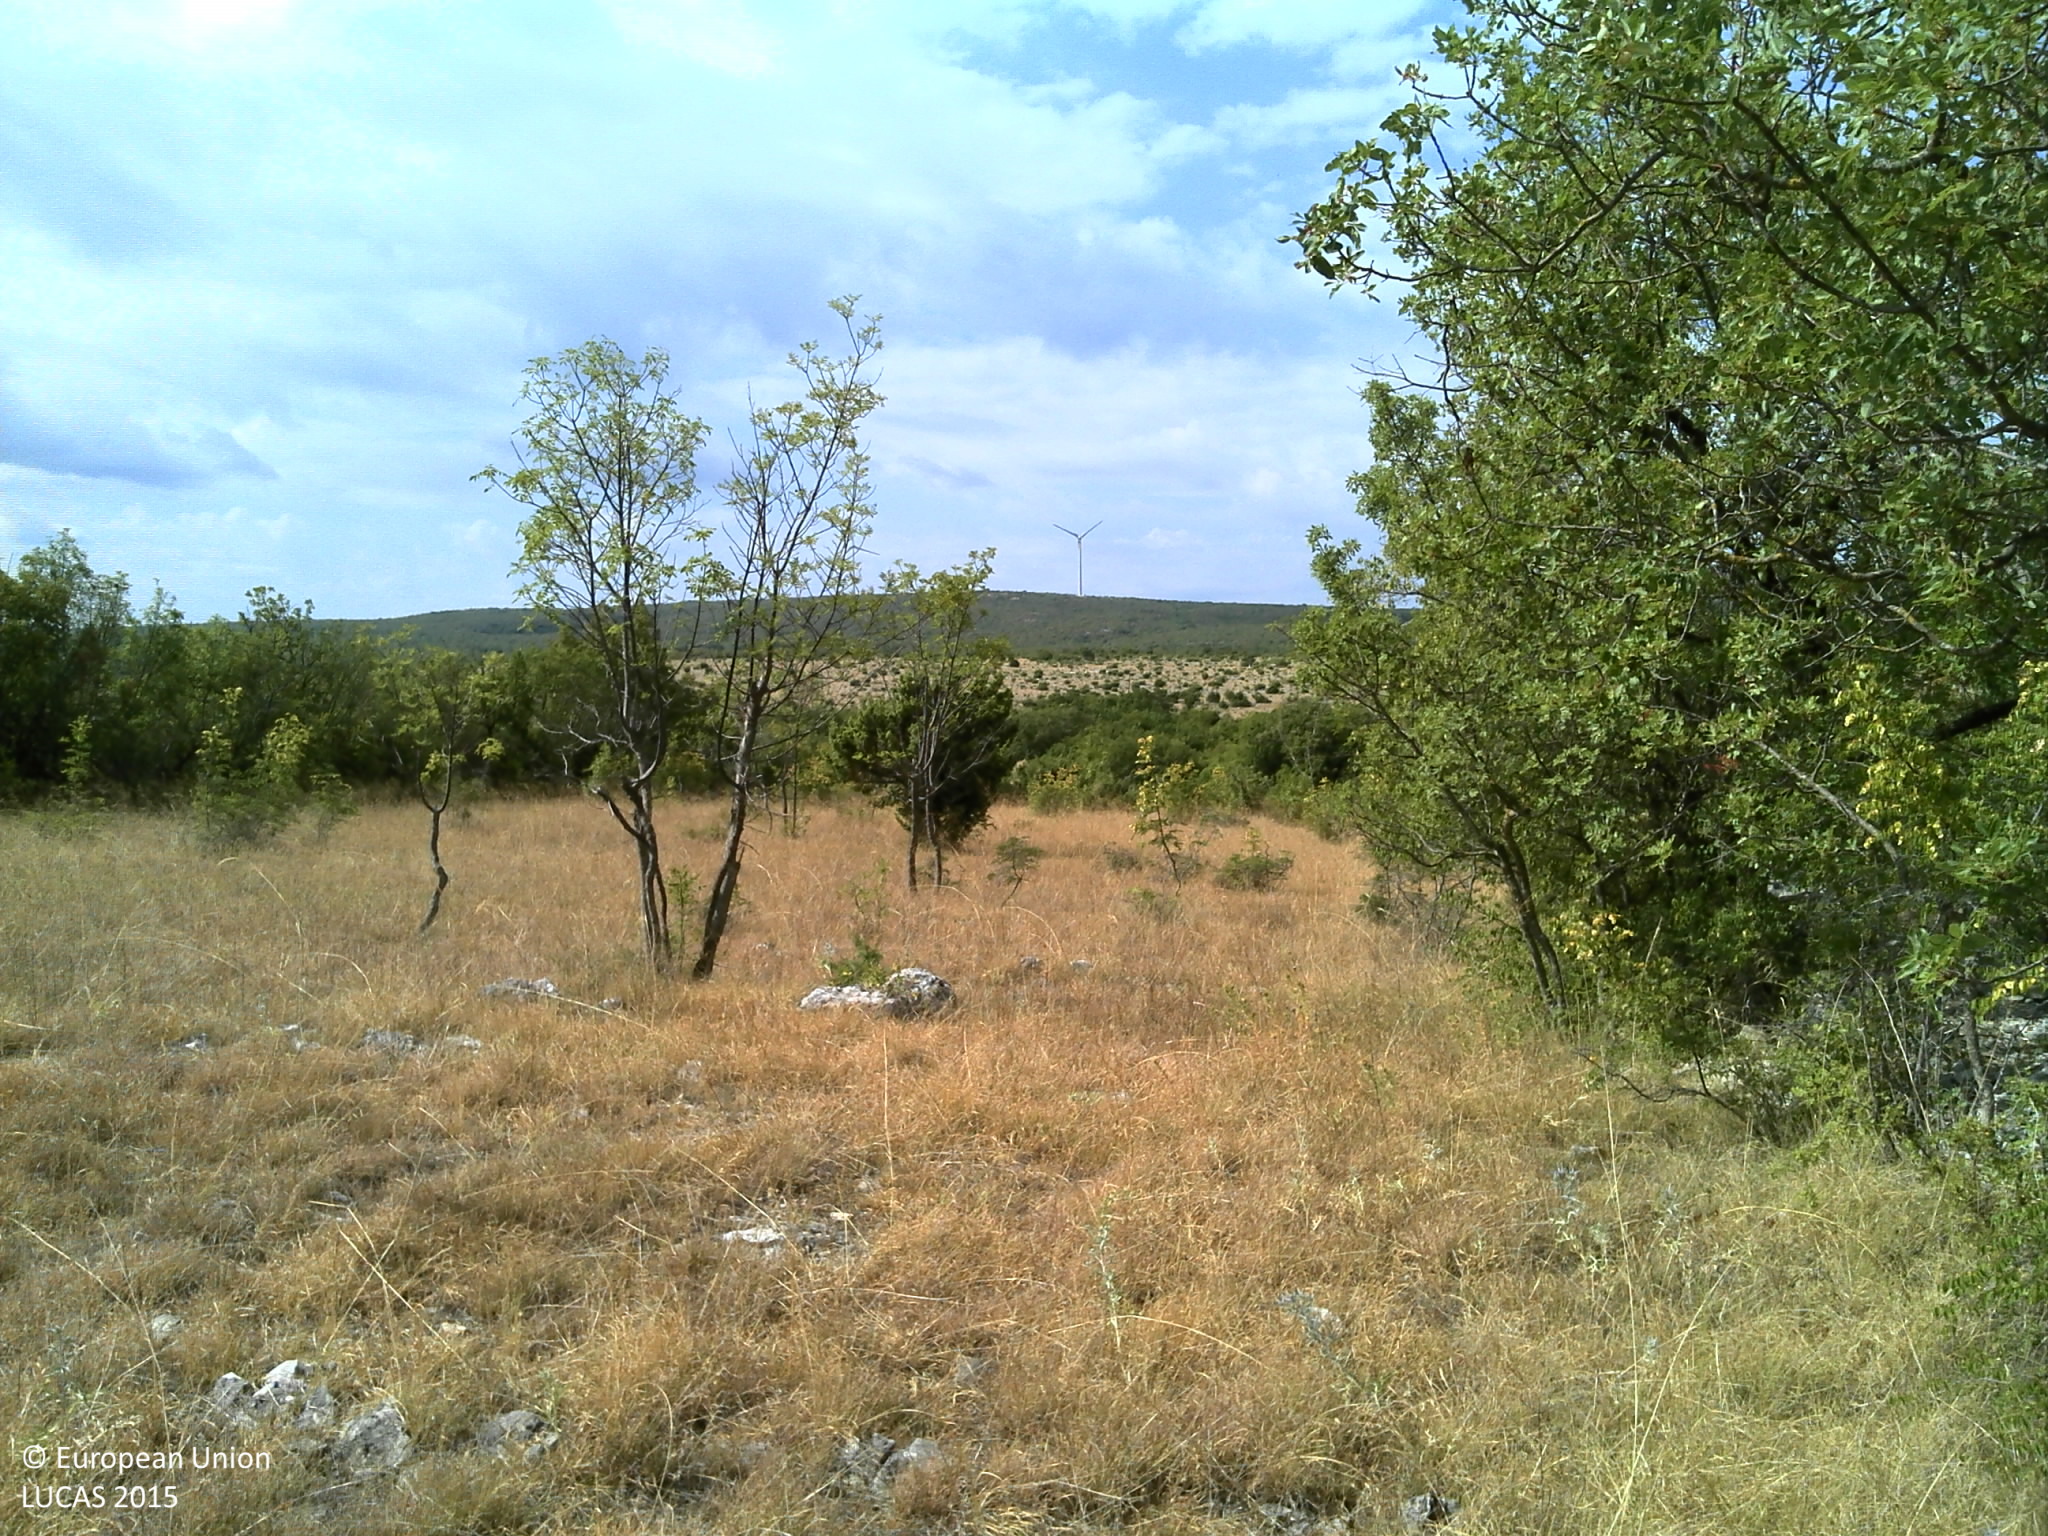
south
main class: Woodland
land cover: Broadleaved woodland
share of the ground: 10 - 25 %
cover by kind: herbaceous plants 70 %, broadleaved forest trees 15 %, shrubs 5 %, consolidated bare surface 5 %, unconsolidated bare surface 5 %
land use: Semi-natural and natural areas not in use
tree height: < 5 m
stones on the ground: < 10 %
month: July
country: HR
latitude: 43.7542
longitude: 16.1143
